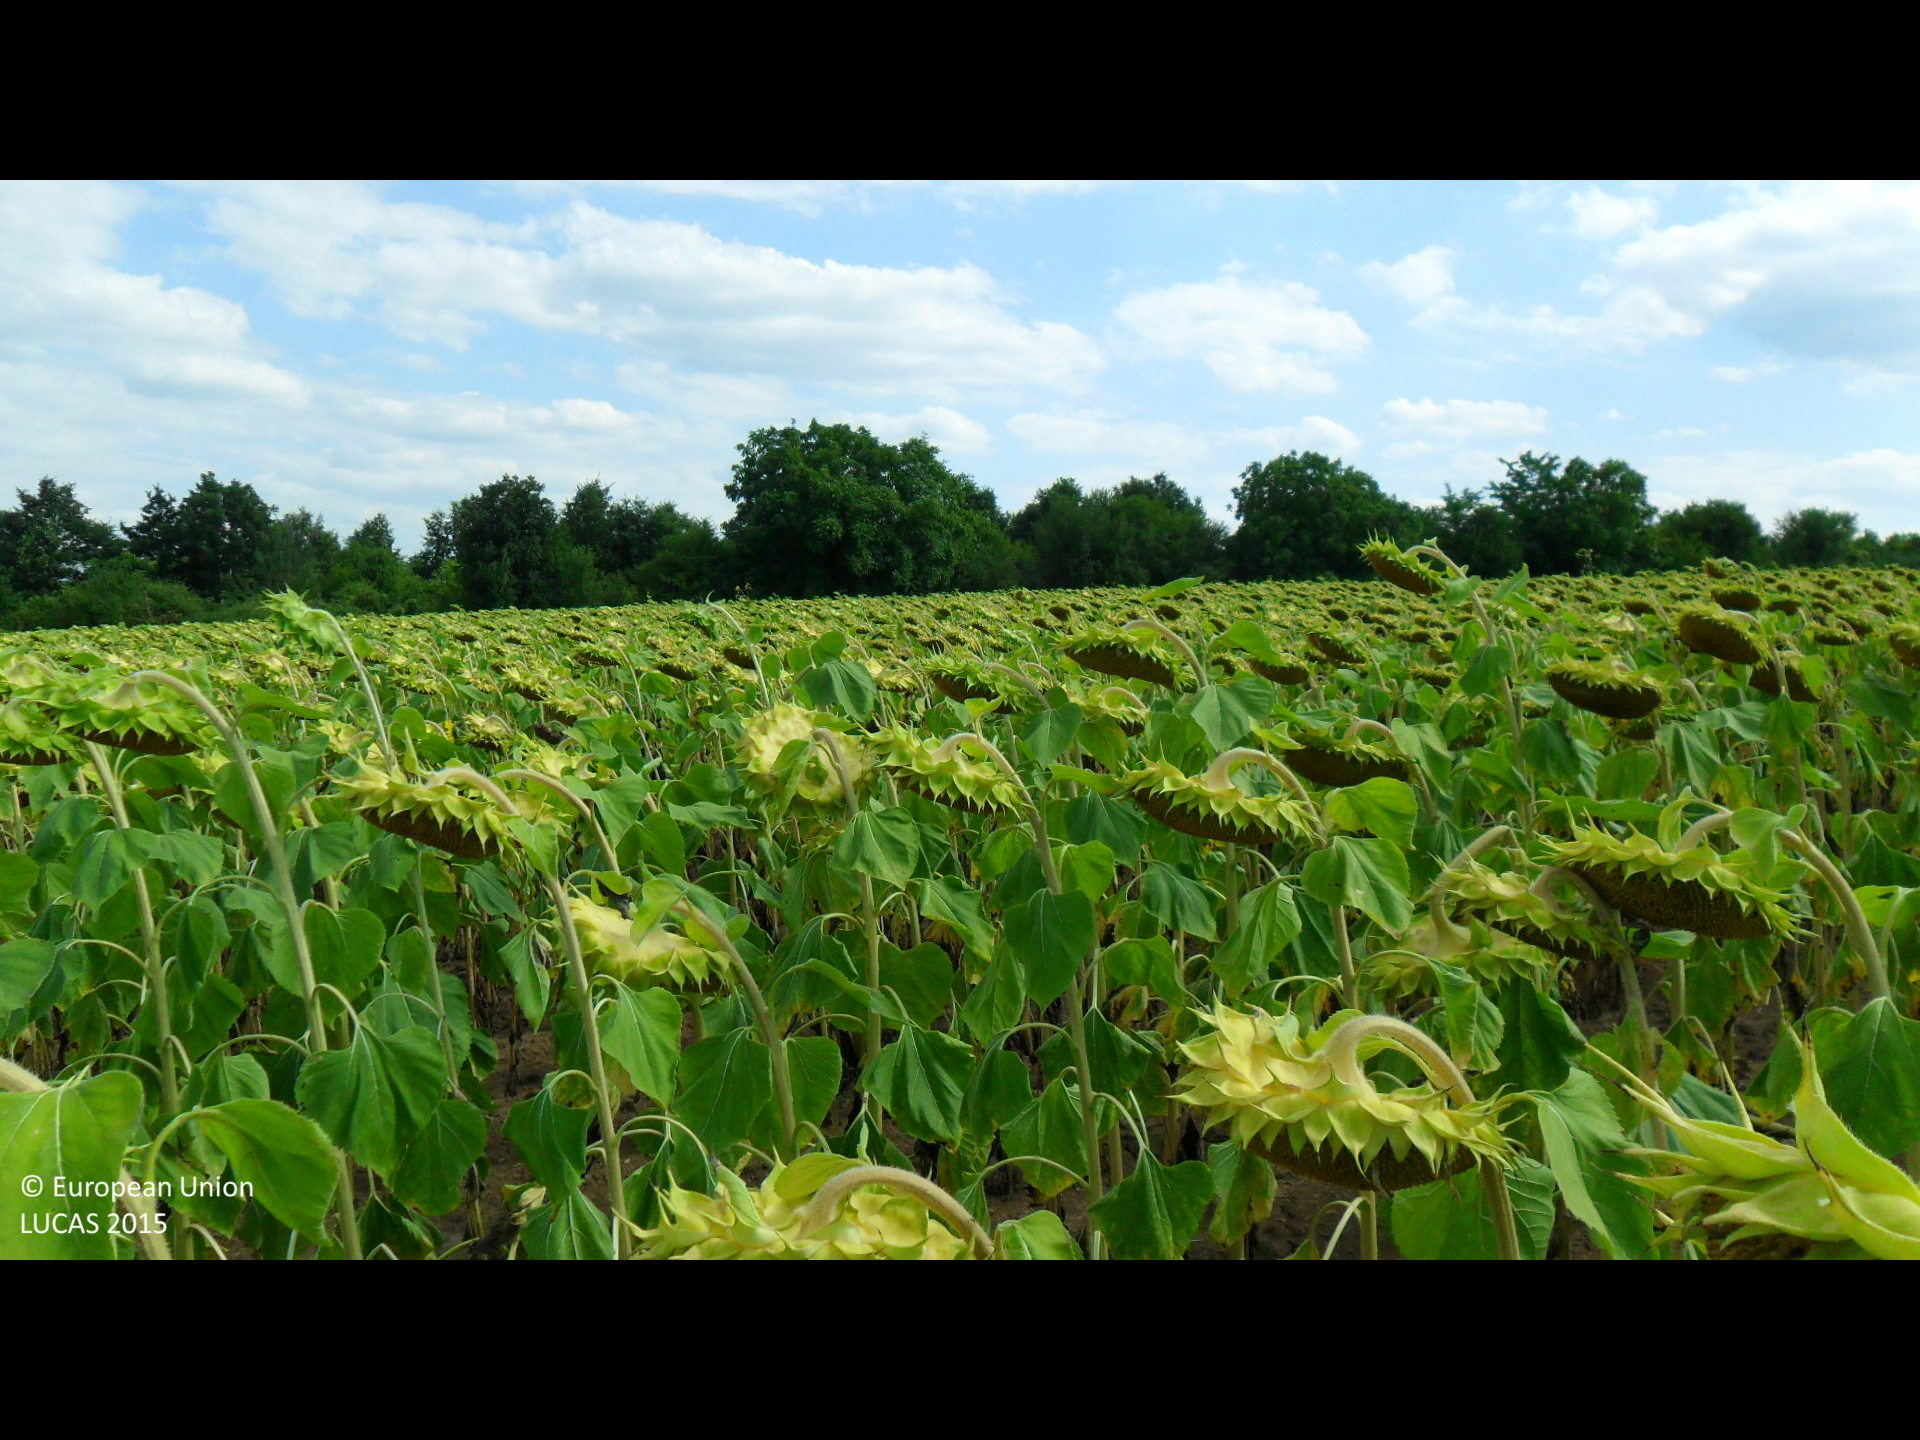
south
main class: Cropland
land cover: Sunflower
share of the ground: > 75 %
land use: Agriculture (excluding fallow land and kitchen gardens)
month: August
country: BG
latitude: 43.3908
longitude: 26.3586
